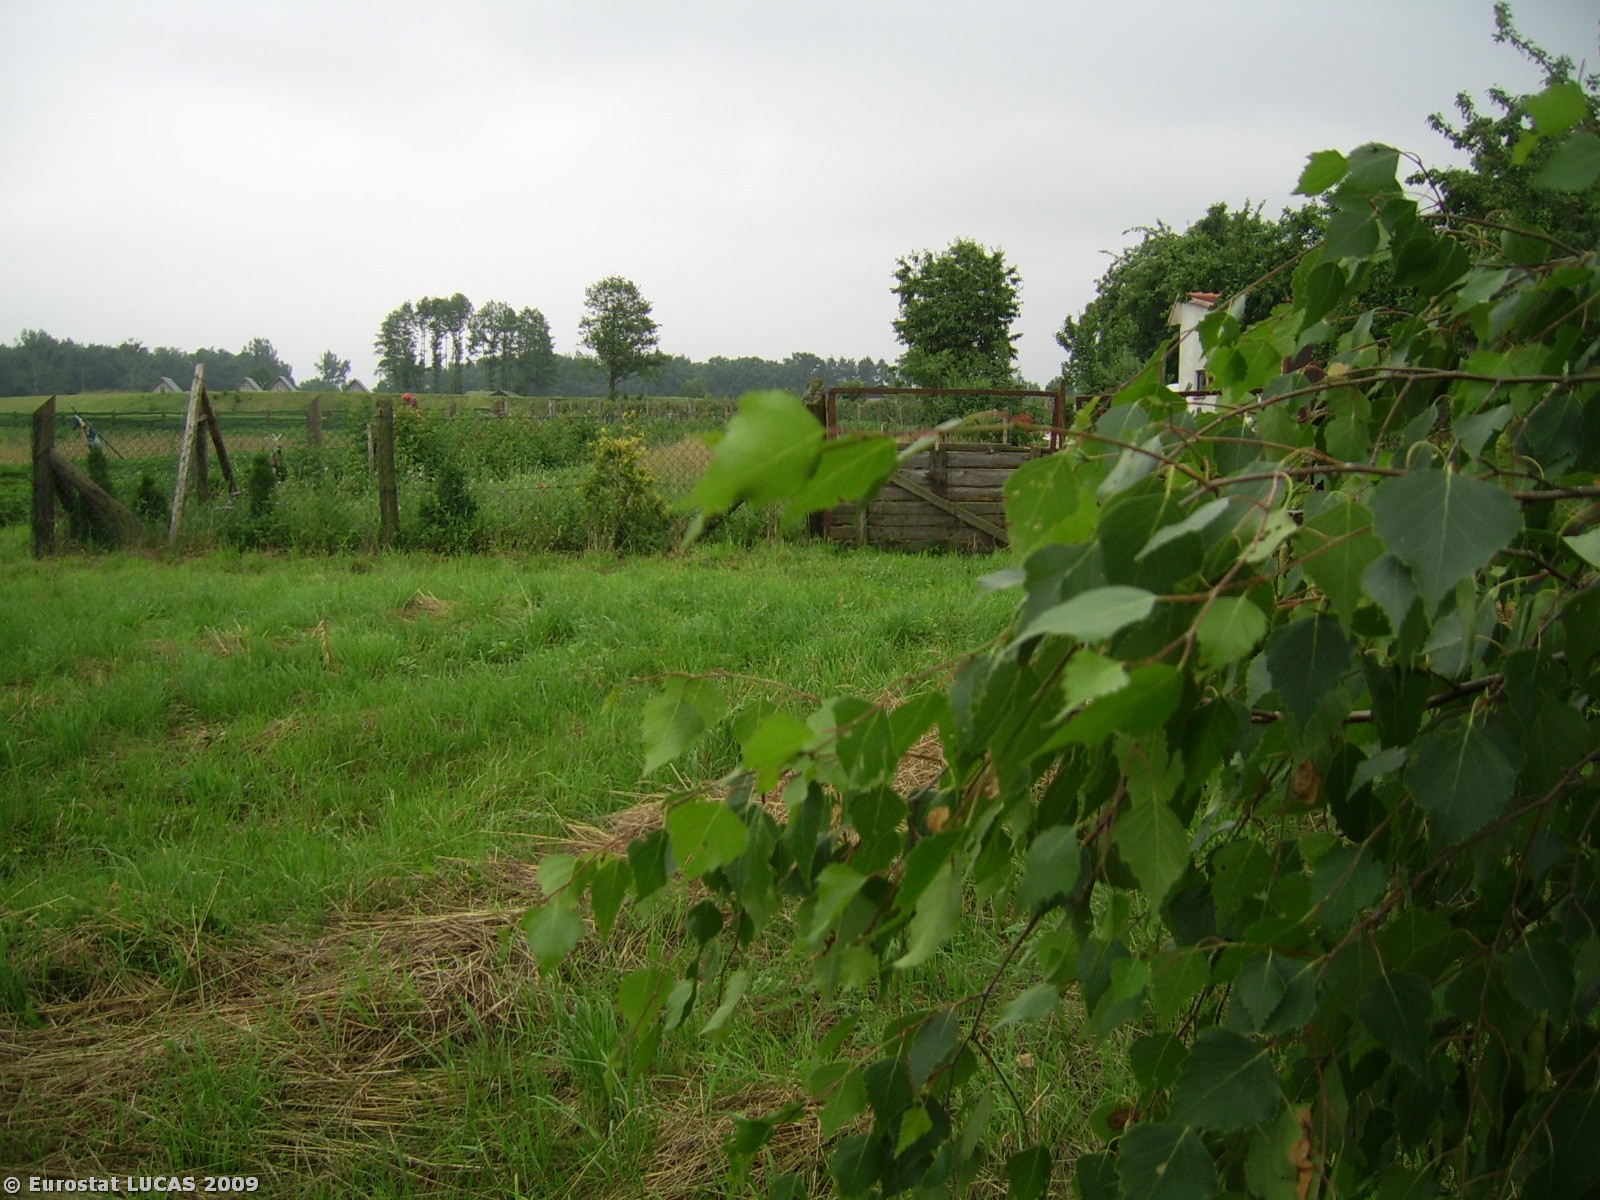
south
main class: Cropland
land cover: Common wheat
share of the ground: > 75 %
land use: Agriculture (excluding fallow land and kitchen gardens)
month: June
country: PL
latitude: 51.5000
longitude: 17.3443
